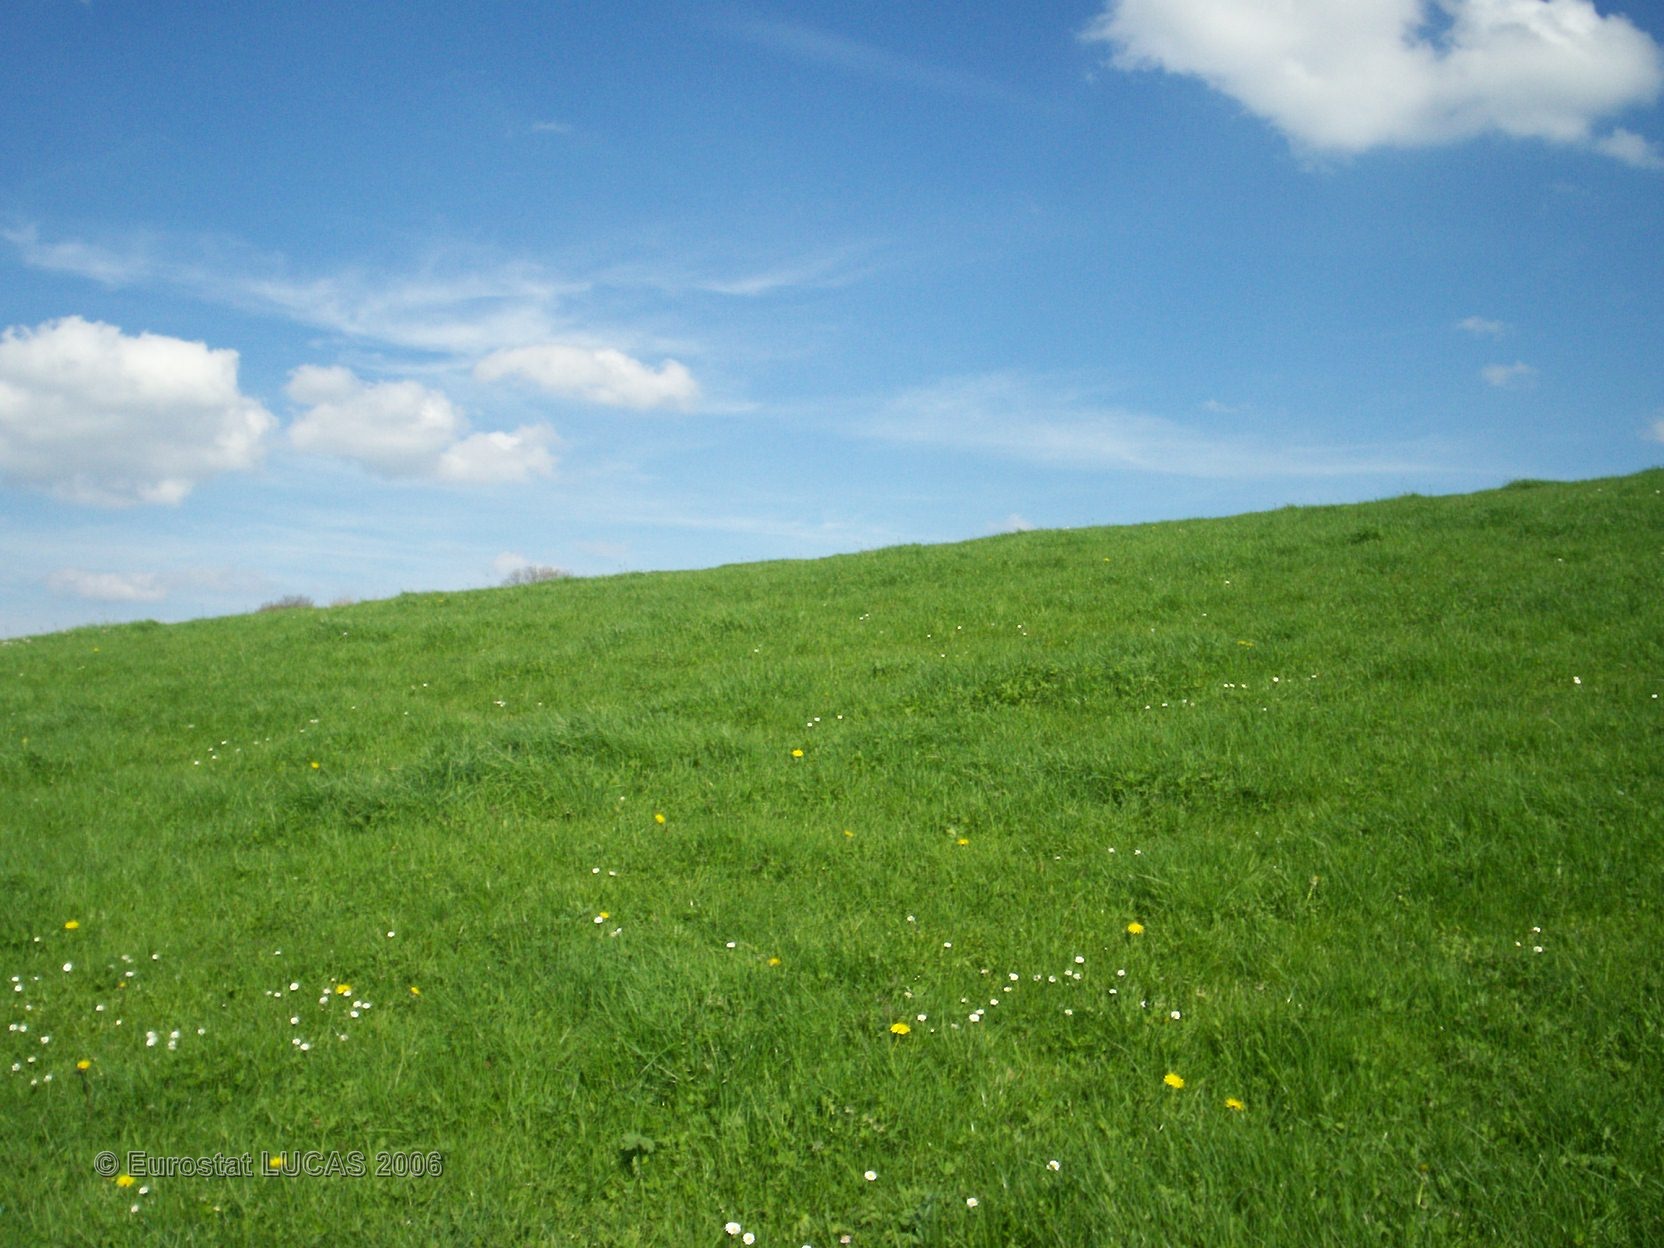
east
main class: Grassland
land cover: Grassland without tree/shrub cover
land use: Agriculture (excluding fallow land and kitchen gardens)
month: May
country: FR
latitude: 49.8079
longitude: 4.3122
